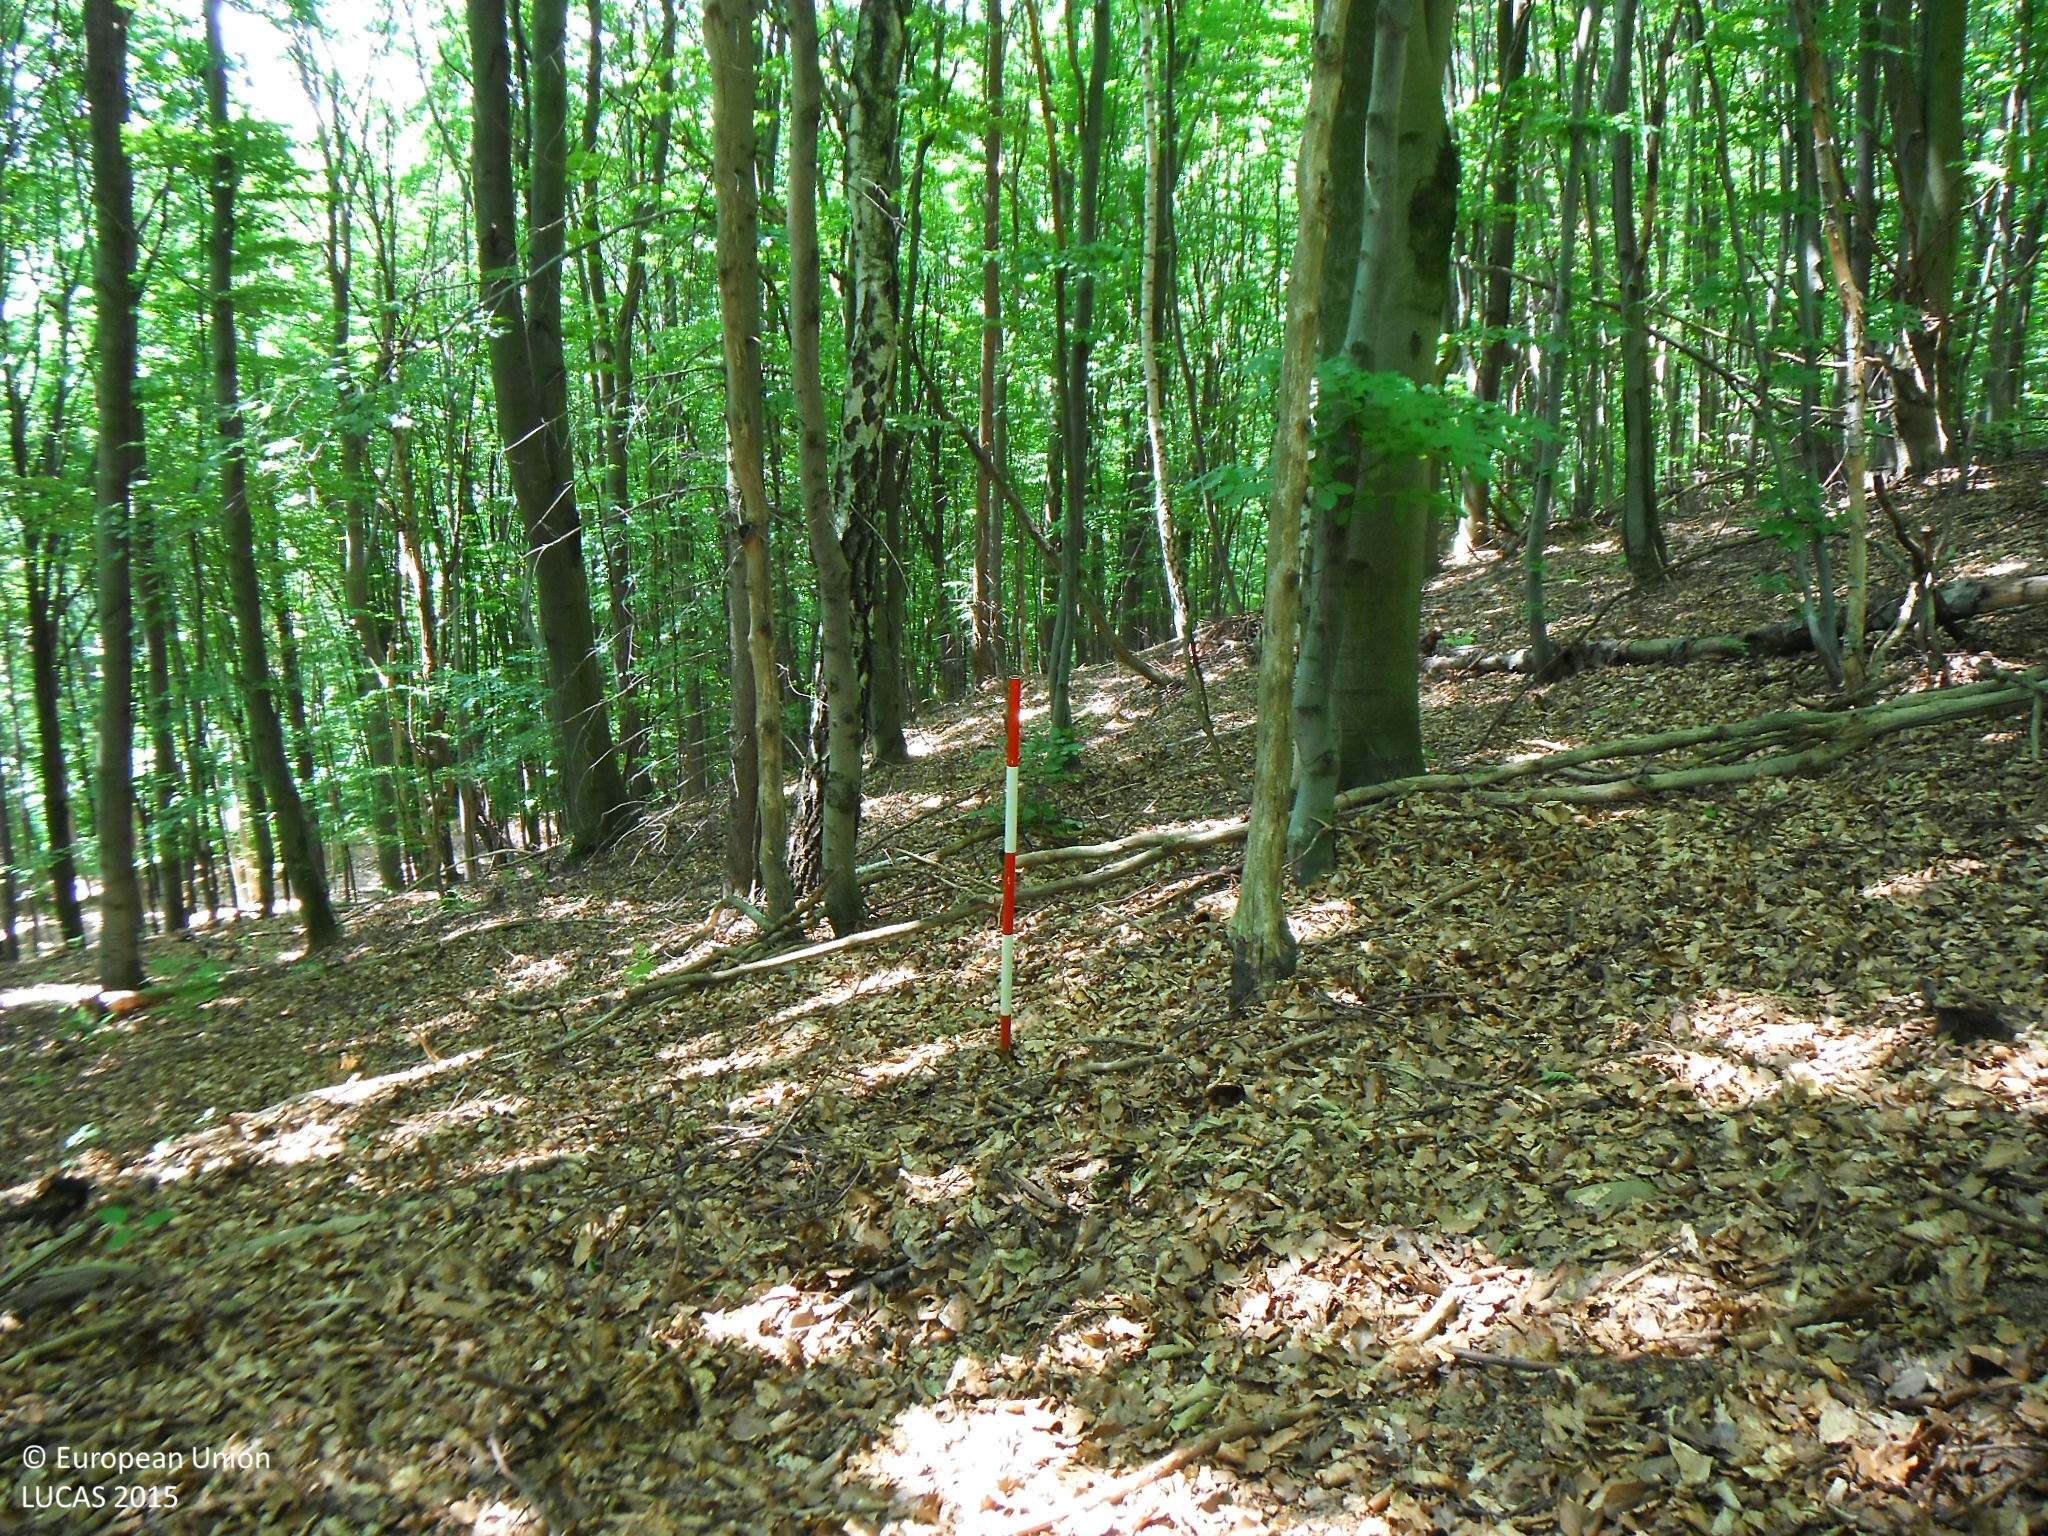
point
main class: Woodland
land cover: Broadleaved woodland
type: beech forest
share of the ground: > 75 %
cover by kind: broadleaved forest trees 100 %
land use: Forestry
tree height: > 5 m
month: July
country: SK
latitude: 49.3775
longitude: 21.1878
